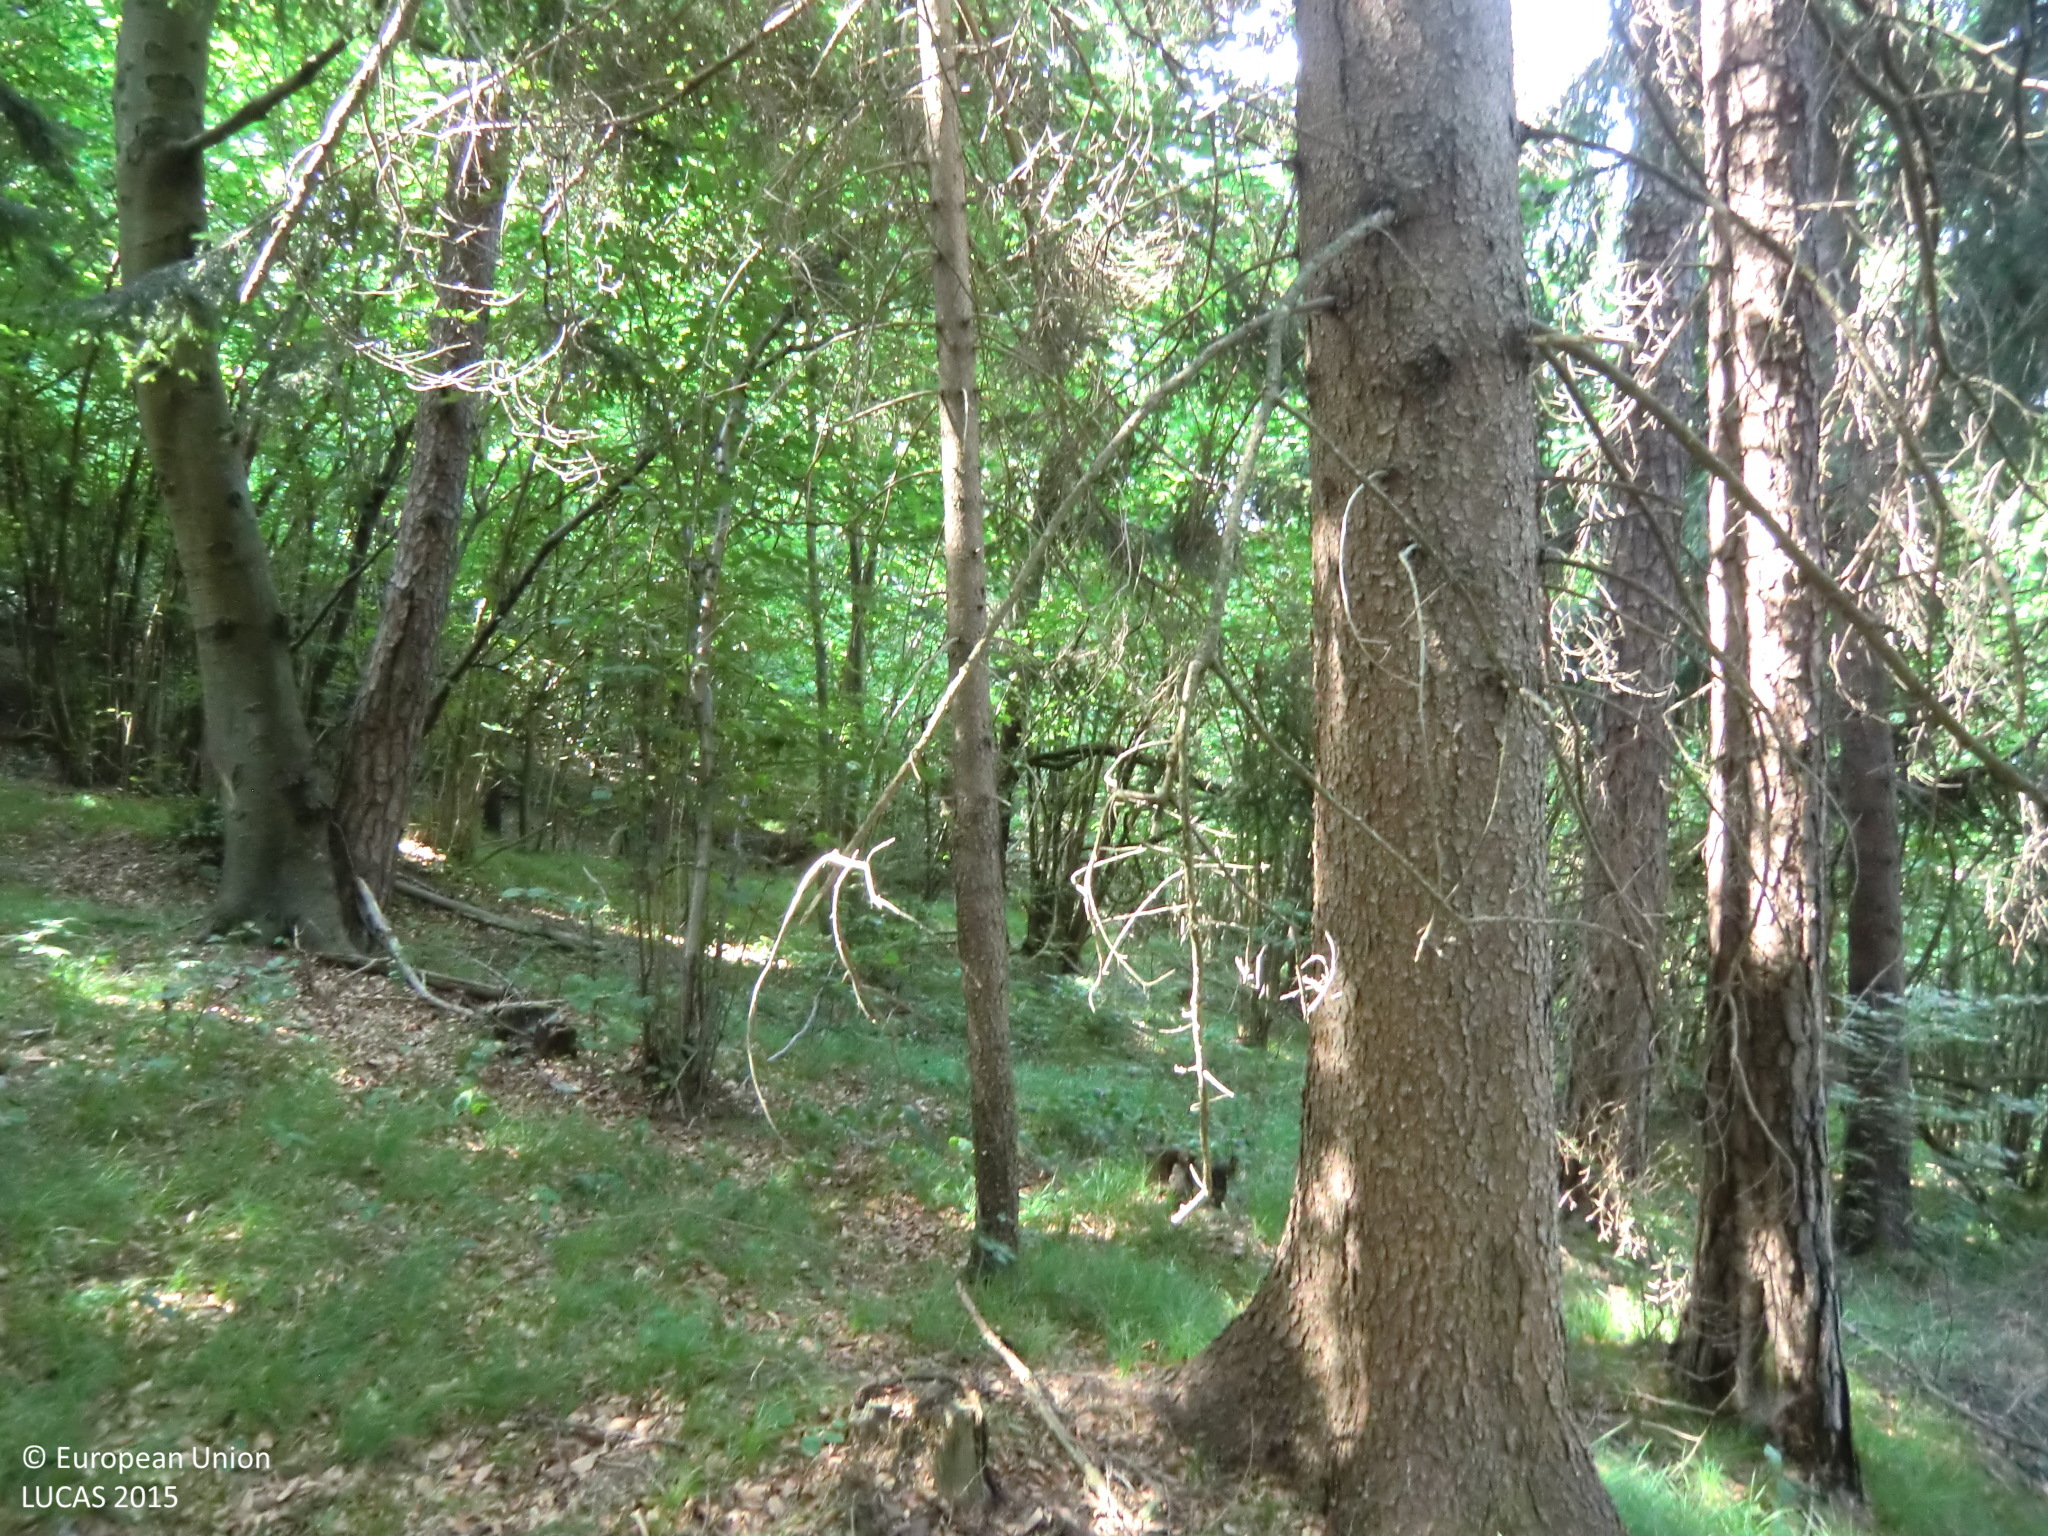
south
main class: Woodland
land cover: Other mixed woodland
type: hemiboreal forest and nemoral coniferous forest and mixed broadleaved-coniferous forest
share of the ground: > 75 %
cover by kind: coniferous forest trees 45 %, broadleaved forest trees 40 %, herbaceous plants 10 %, unconsolidated bare surface 5 %
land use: Forestry
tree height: > 5 m
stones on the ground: < 10 %
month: July
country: AT
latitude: 47.1522
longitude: 15.4205
